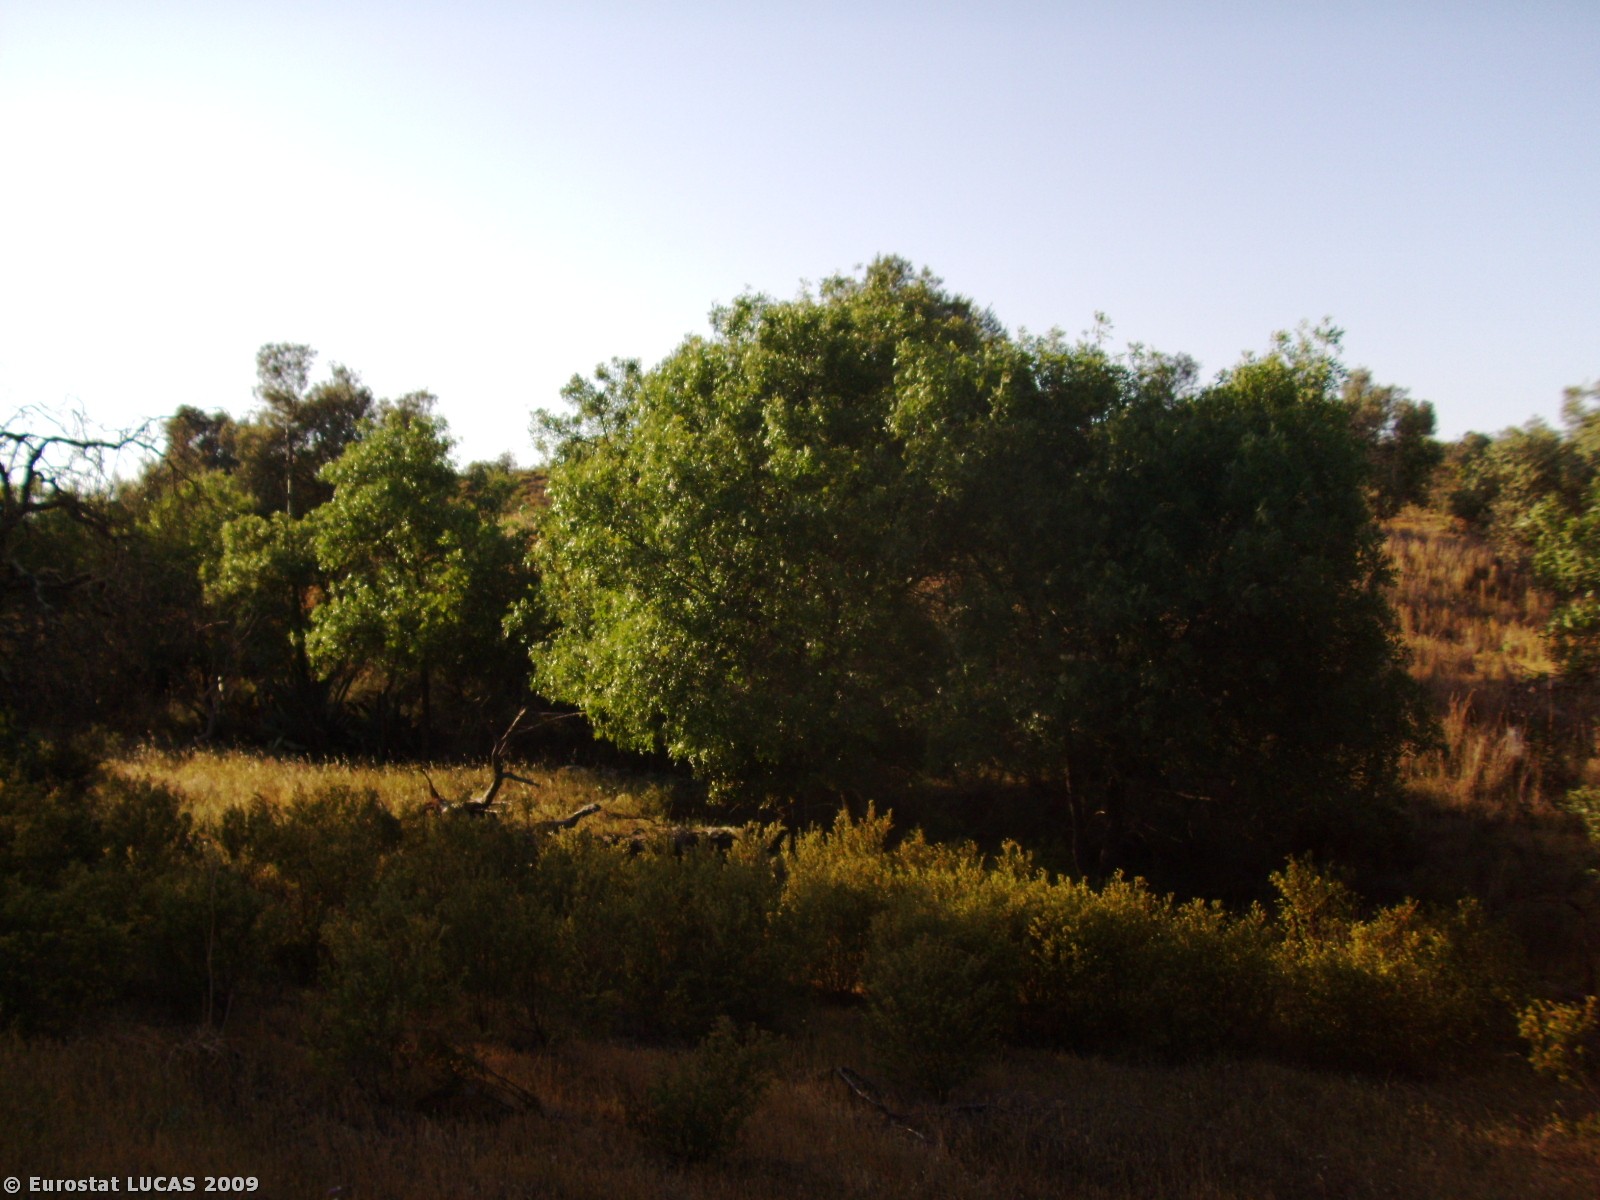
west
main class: Cropland
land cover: Olive groves
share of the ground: < 10 %
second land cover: Spontaneously vegetated surfaces
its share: > 75 %
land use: Agriculture (excluding fallow land and kitchen gardens)
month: May
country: PT
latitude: 37.2852
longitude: -7.4529
